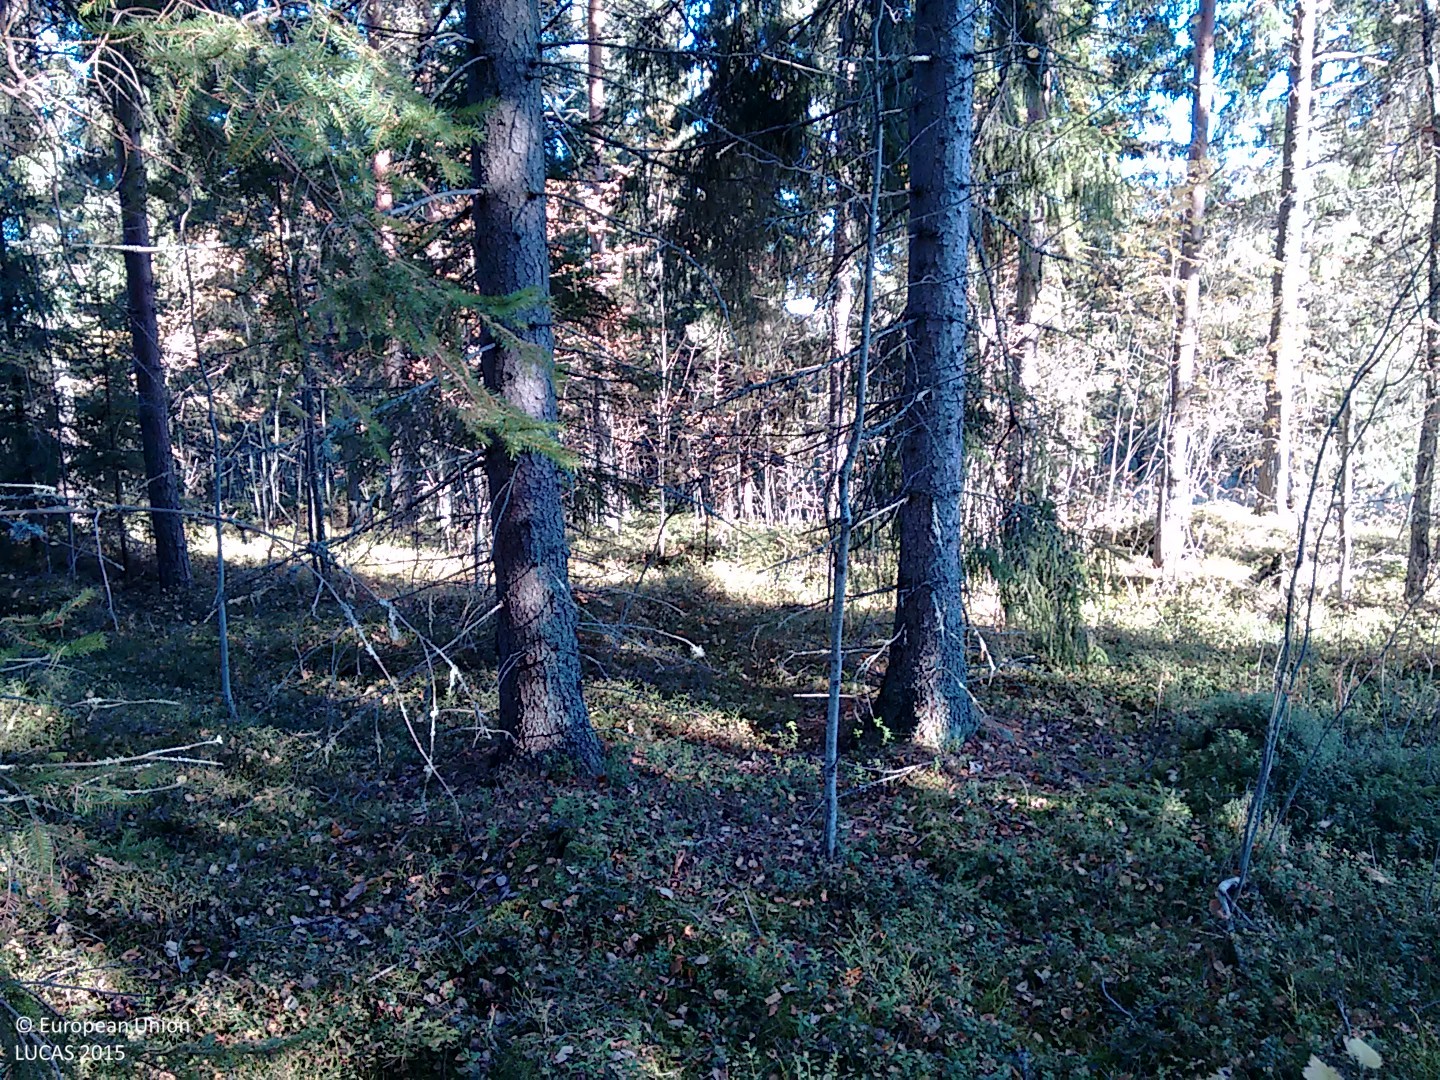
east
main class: Woodland
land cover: Spruce dominated mixed woodland
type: boreal forest
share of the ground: > 75 %
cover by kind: coniferous forest trees 65 %, broadleaved forest trees 25 %, shrubs 10 %
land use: Forestry
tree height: > 5 m
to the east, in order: Spruce dominated mixed woodland; Dry stone walls; Ditches and canals; Grass margins; Tracks; Grass margins; Ditches and canals; Pine dominated mixed woodland; Ditches and canals; Grass margins; Tracks; Grass margins; Ditches and canals; Spruce dominated coniferous woodland
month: October
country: FI
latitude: 62.4475
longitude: 26.1946
